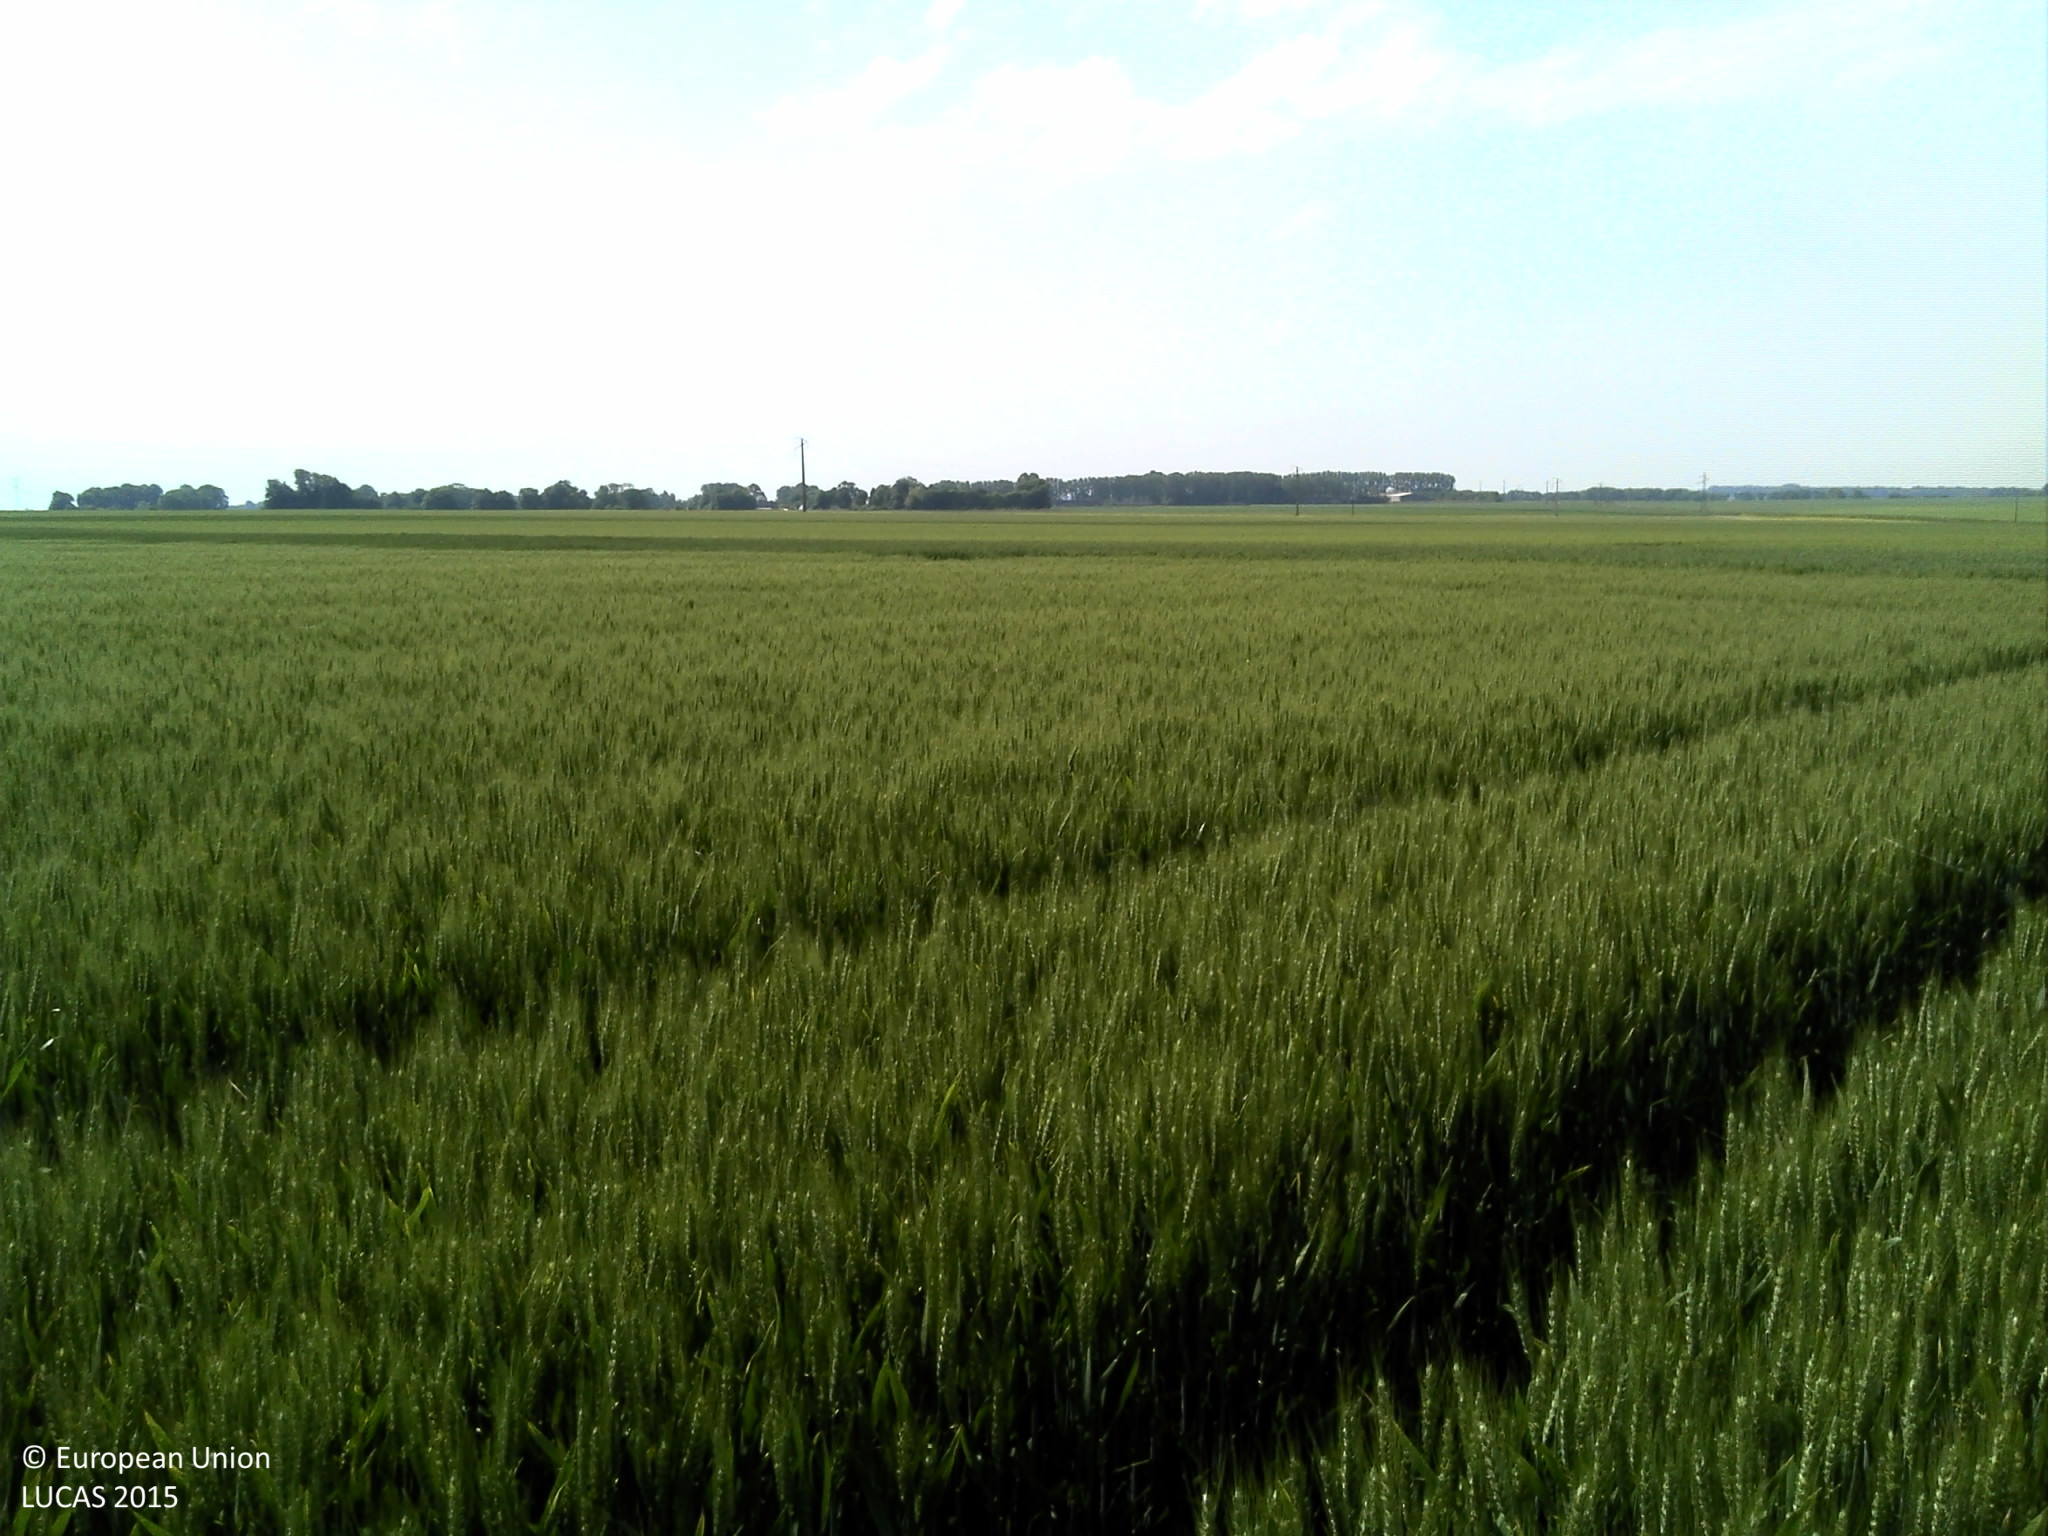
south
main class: Cropland
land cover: Common wheat
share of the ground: > 75 %
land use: Agriculture (excluding fallow land and kitchen gardens)
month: June
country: FR
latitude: 49.7595
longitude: 1.0519
